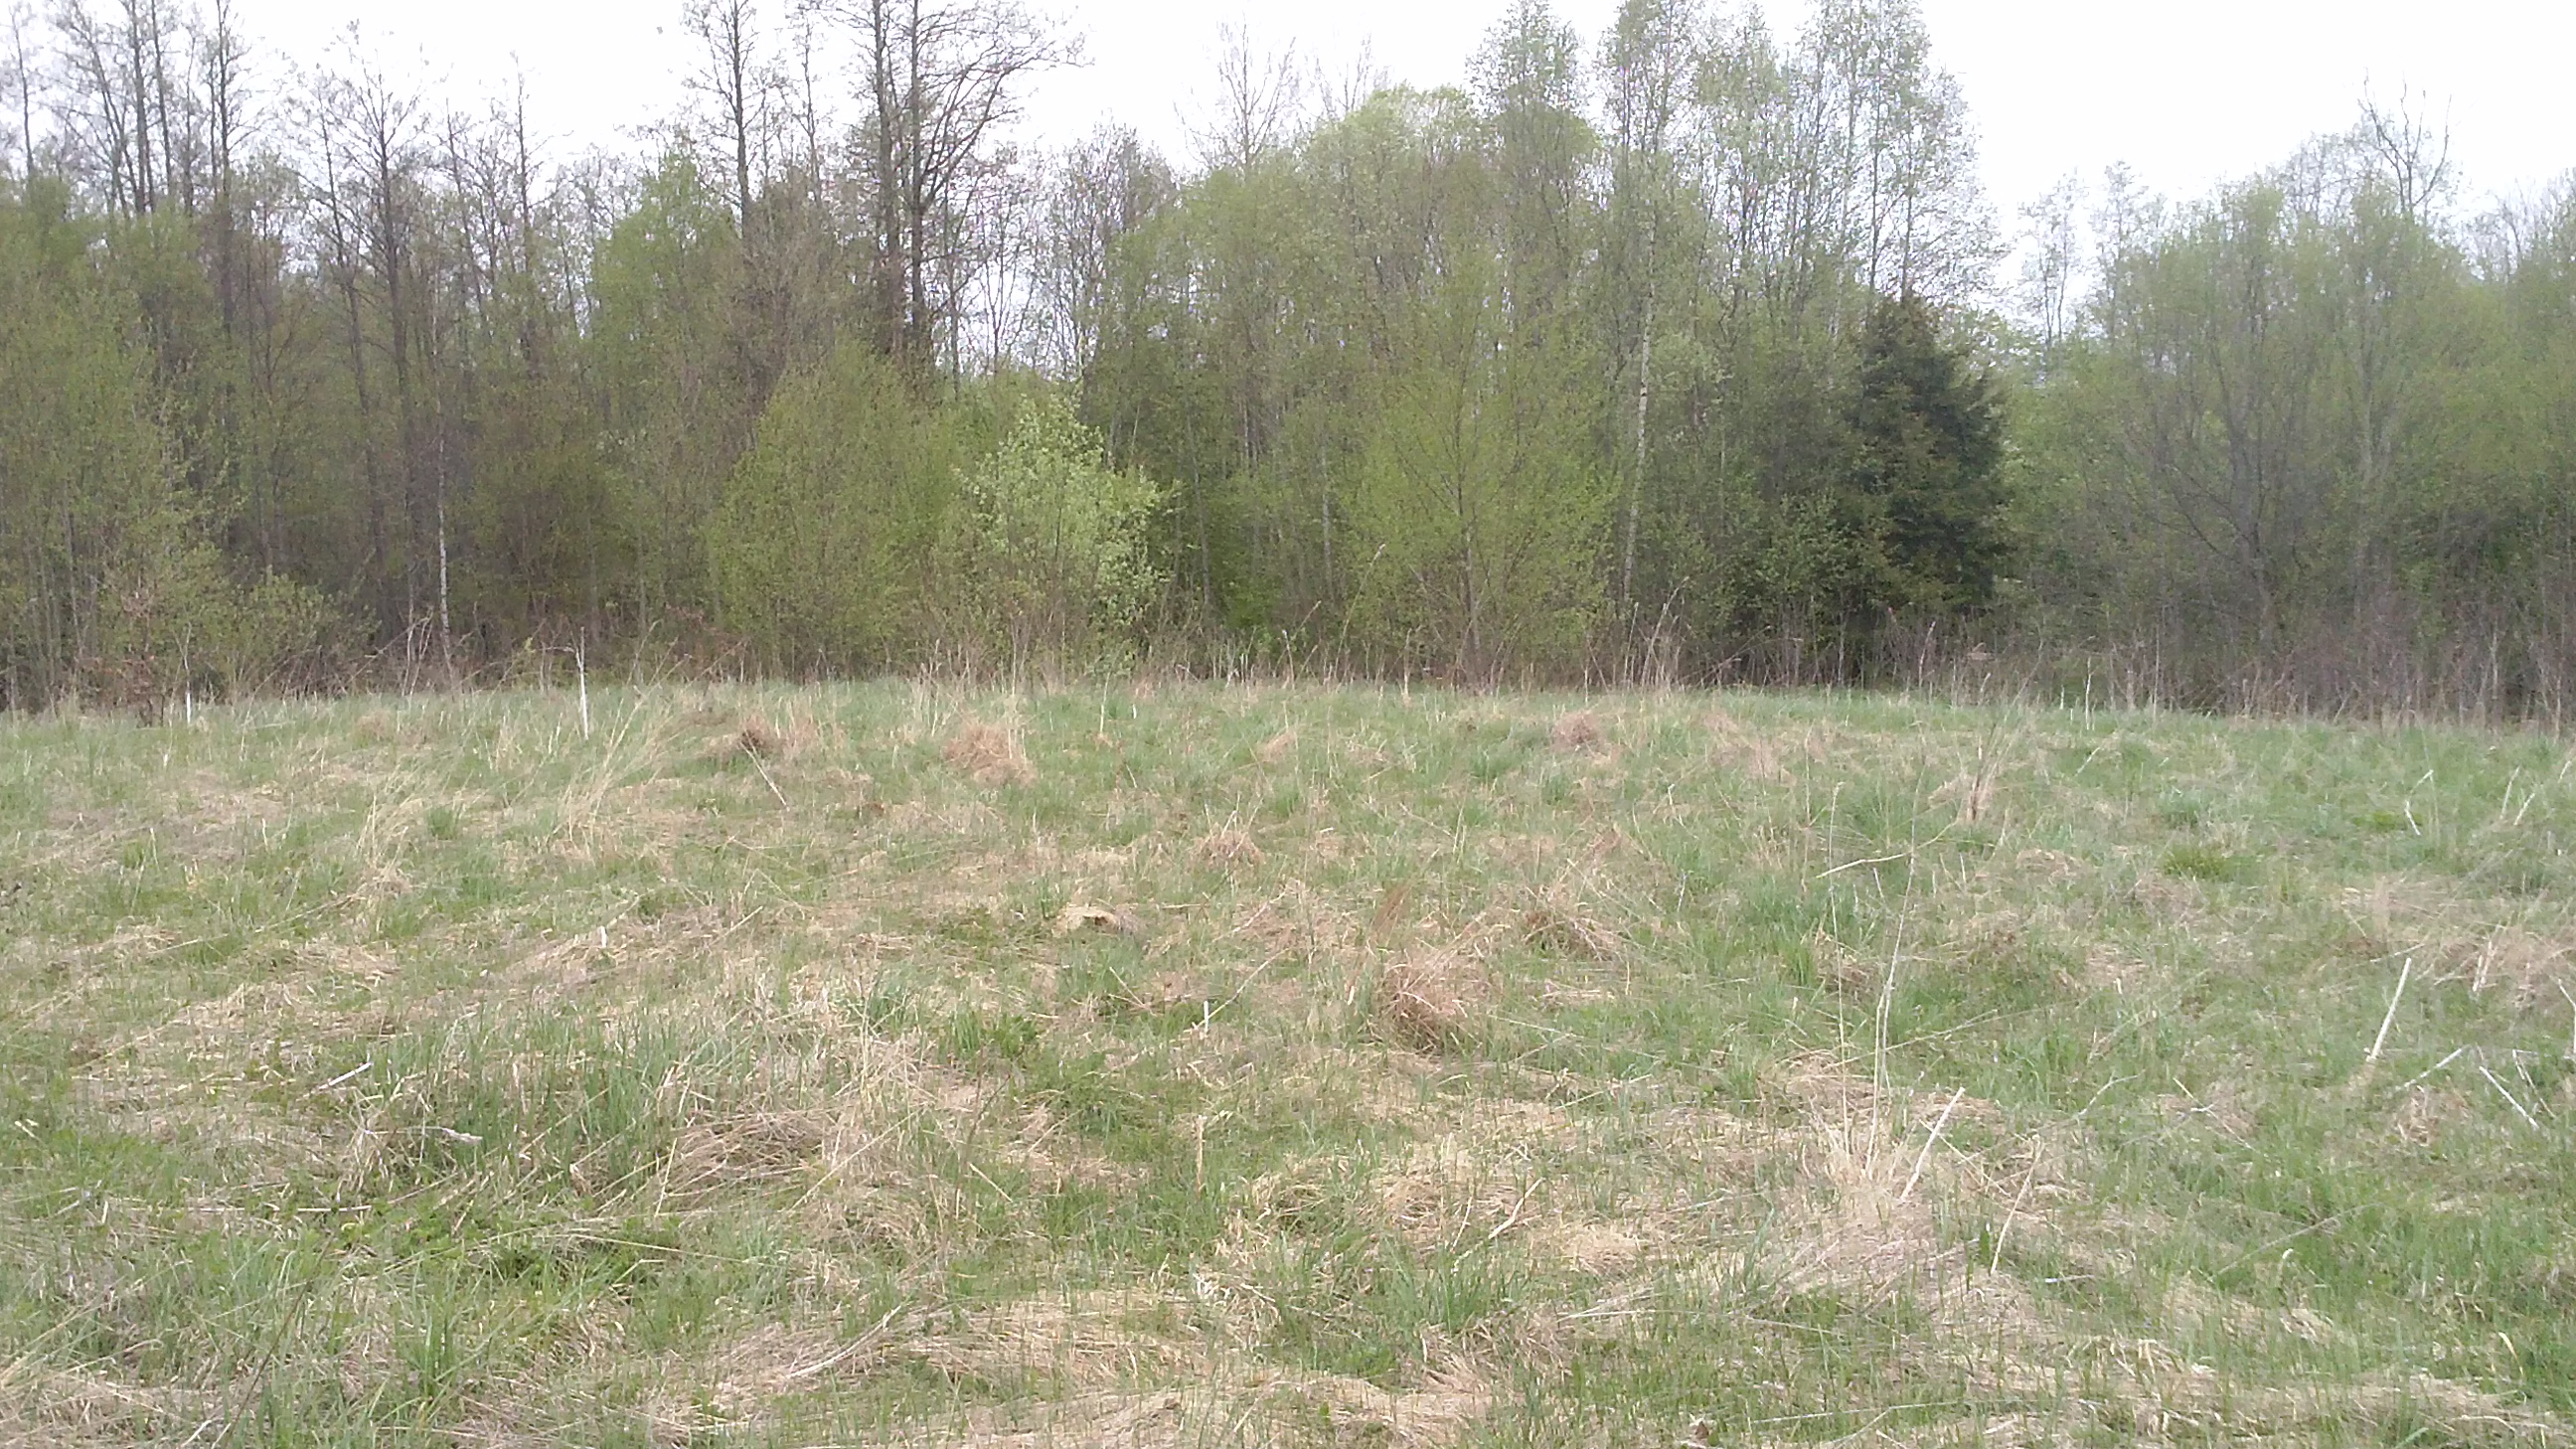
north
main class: Grassland
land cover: Grassland without tree/shrub cover
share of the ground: > 75 %
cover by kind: herbaceous plants 100 %
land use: Agriculture (excluding fallow land and kitchen gardens)
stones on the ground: < 10 %
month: May
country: LV
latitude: 55.9710
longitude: 27.2042
